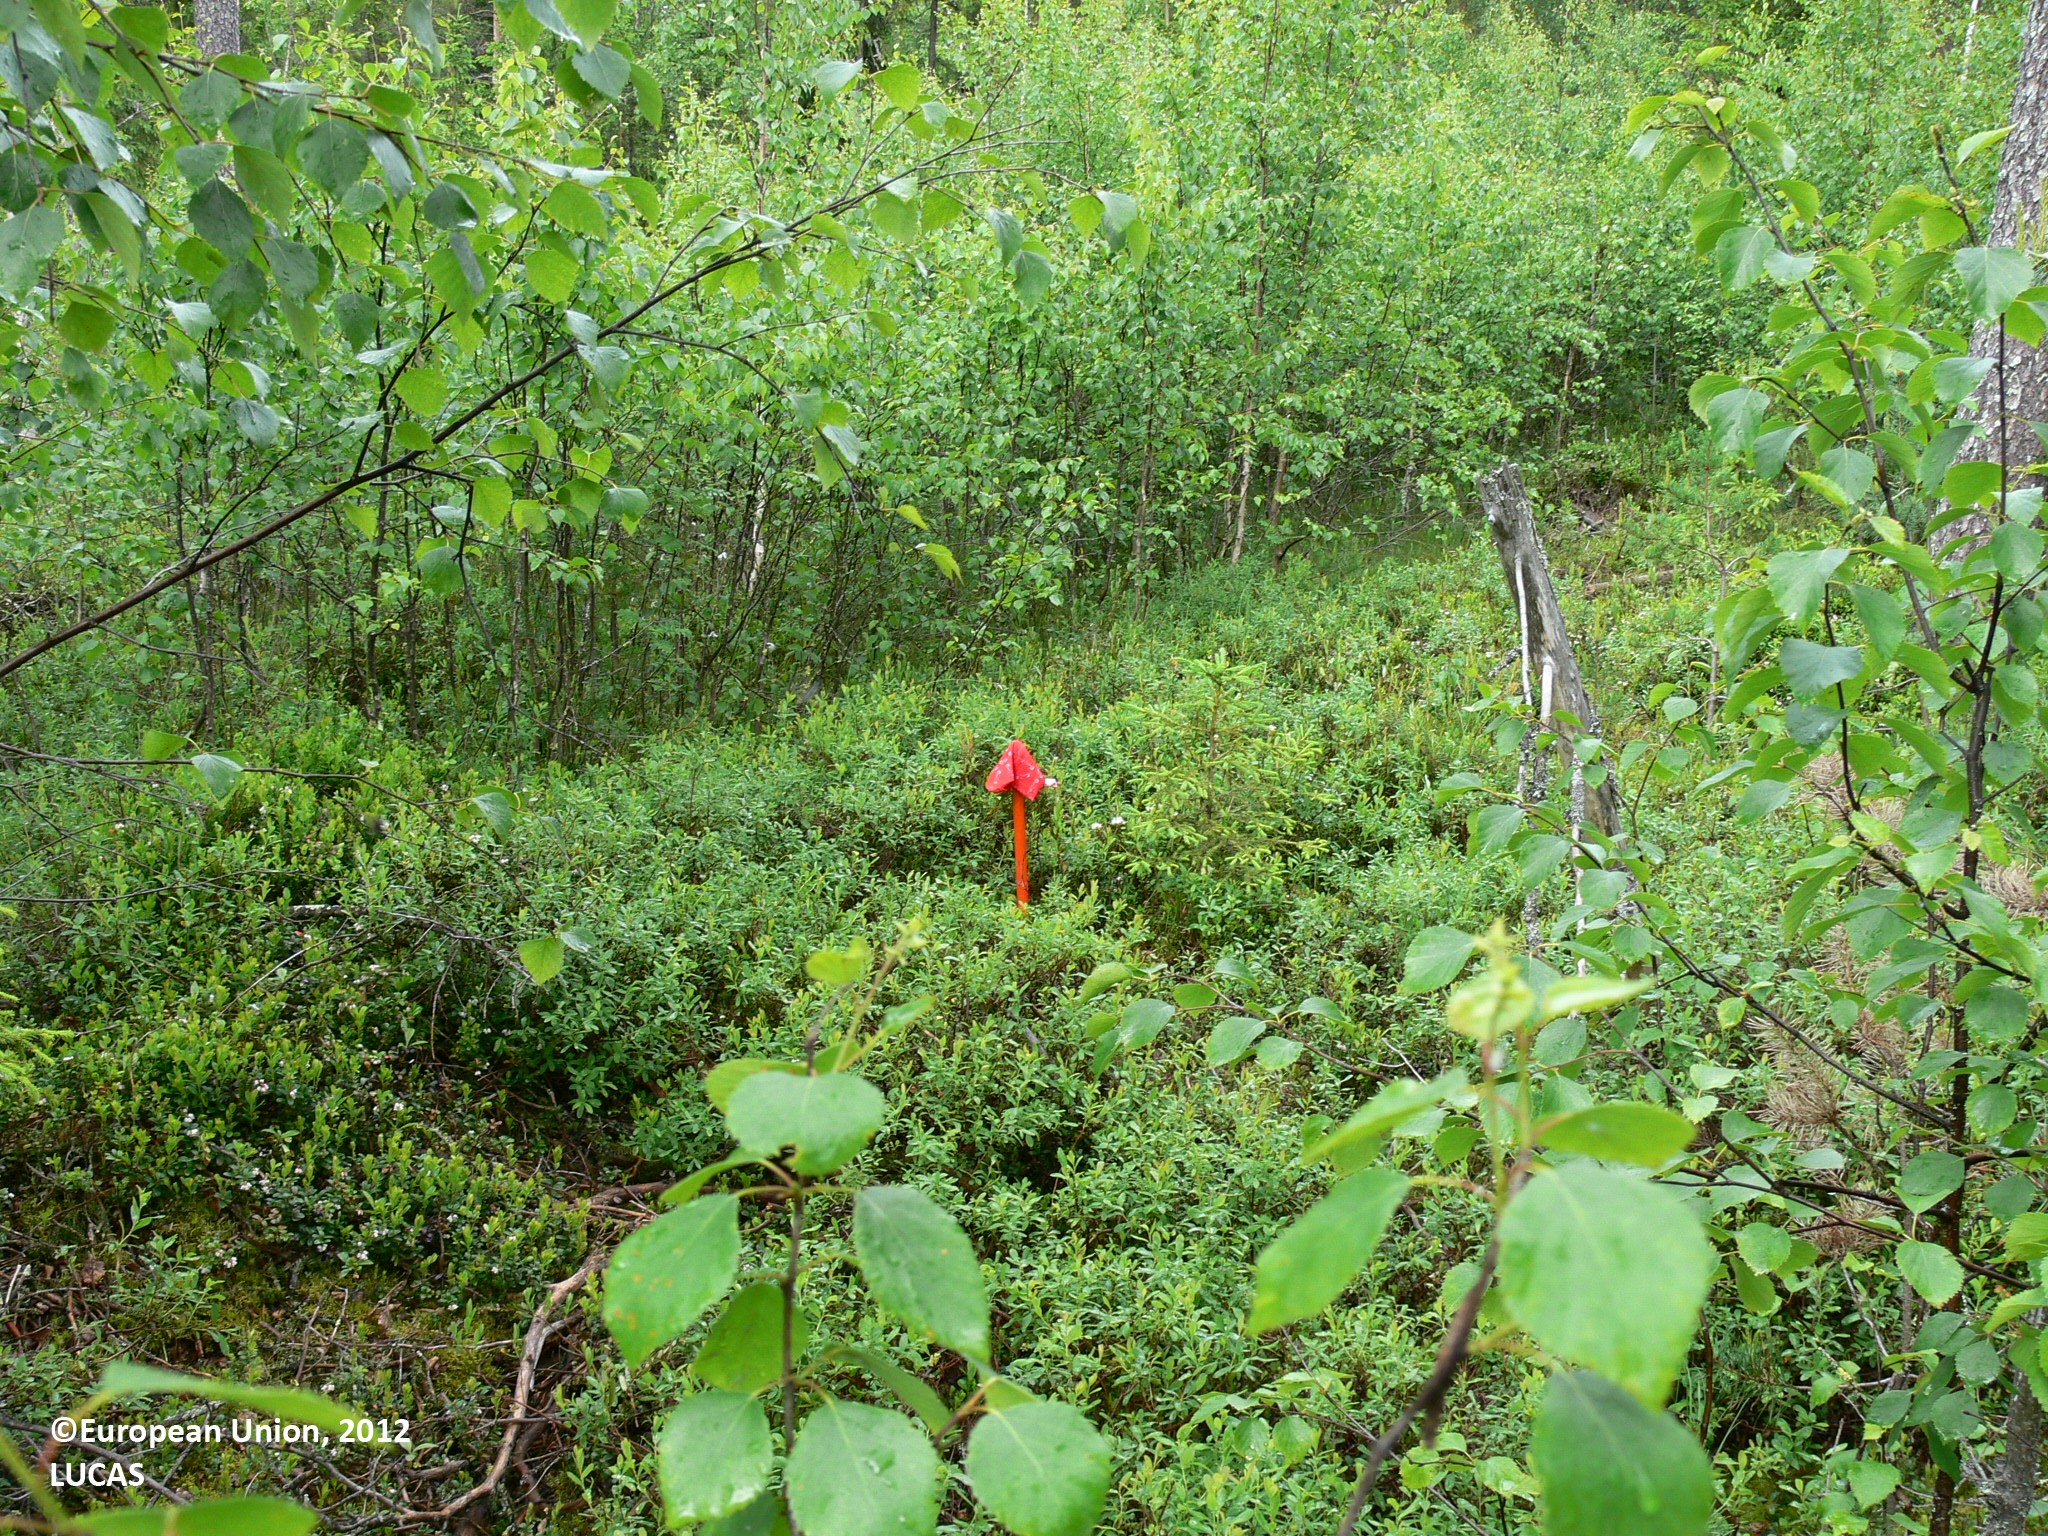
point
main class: Woodland
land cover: Other mixed woodland
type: boreal forest
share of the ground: 50 - 75 %
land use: Forestry
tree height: > 5 m
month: June
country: FI
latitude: 62.9126
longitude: 29.3013
